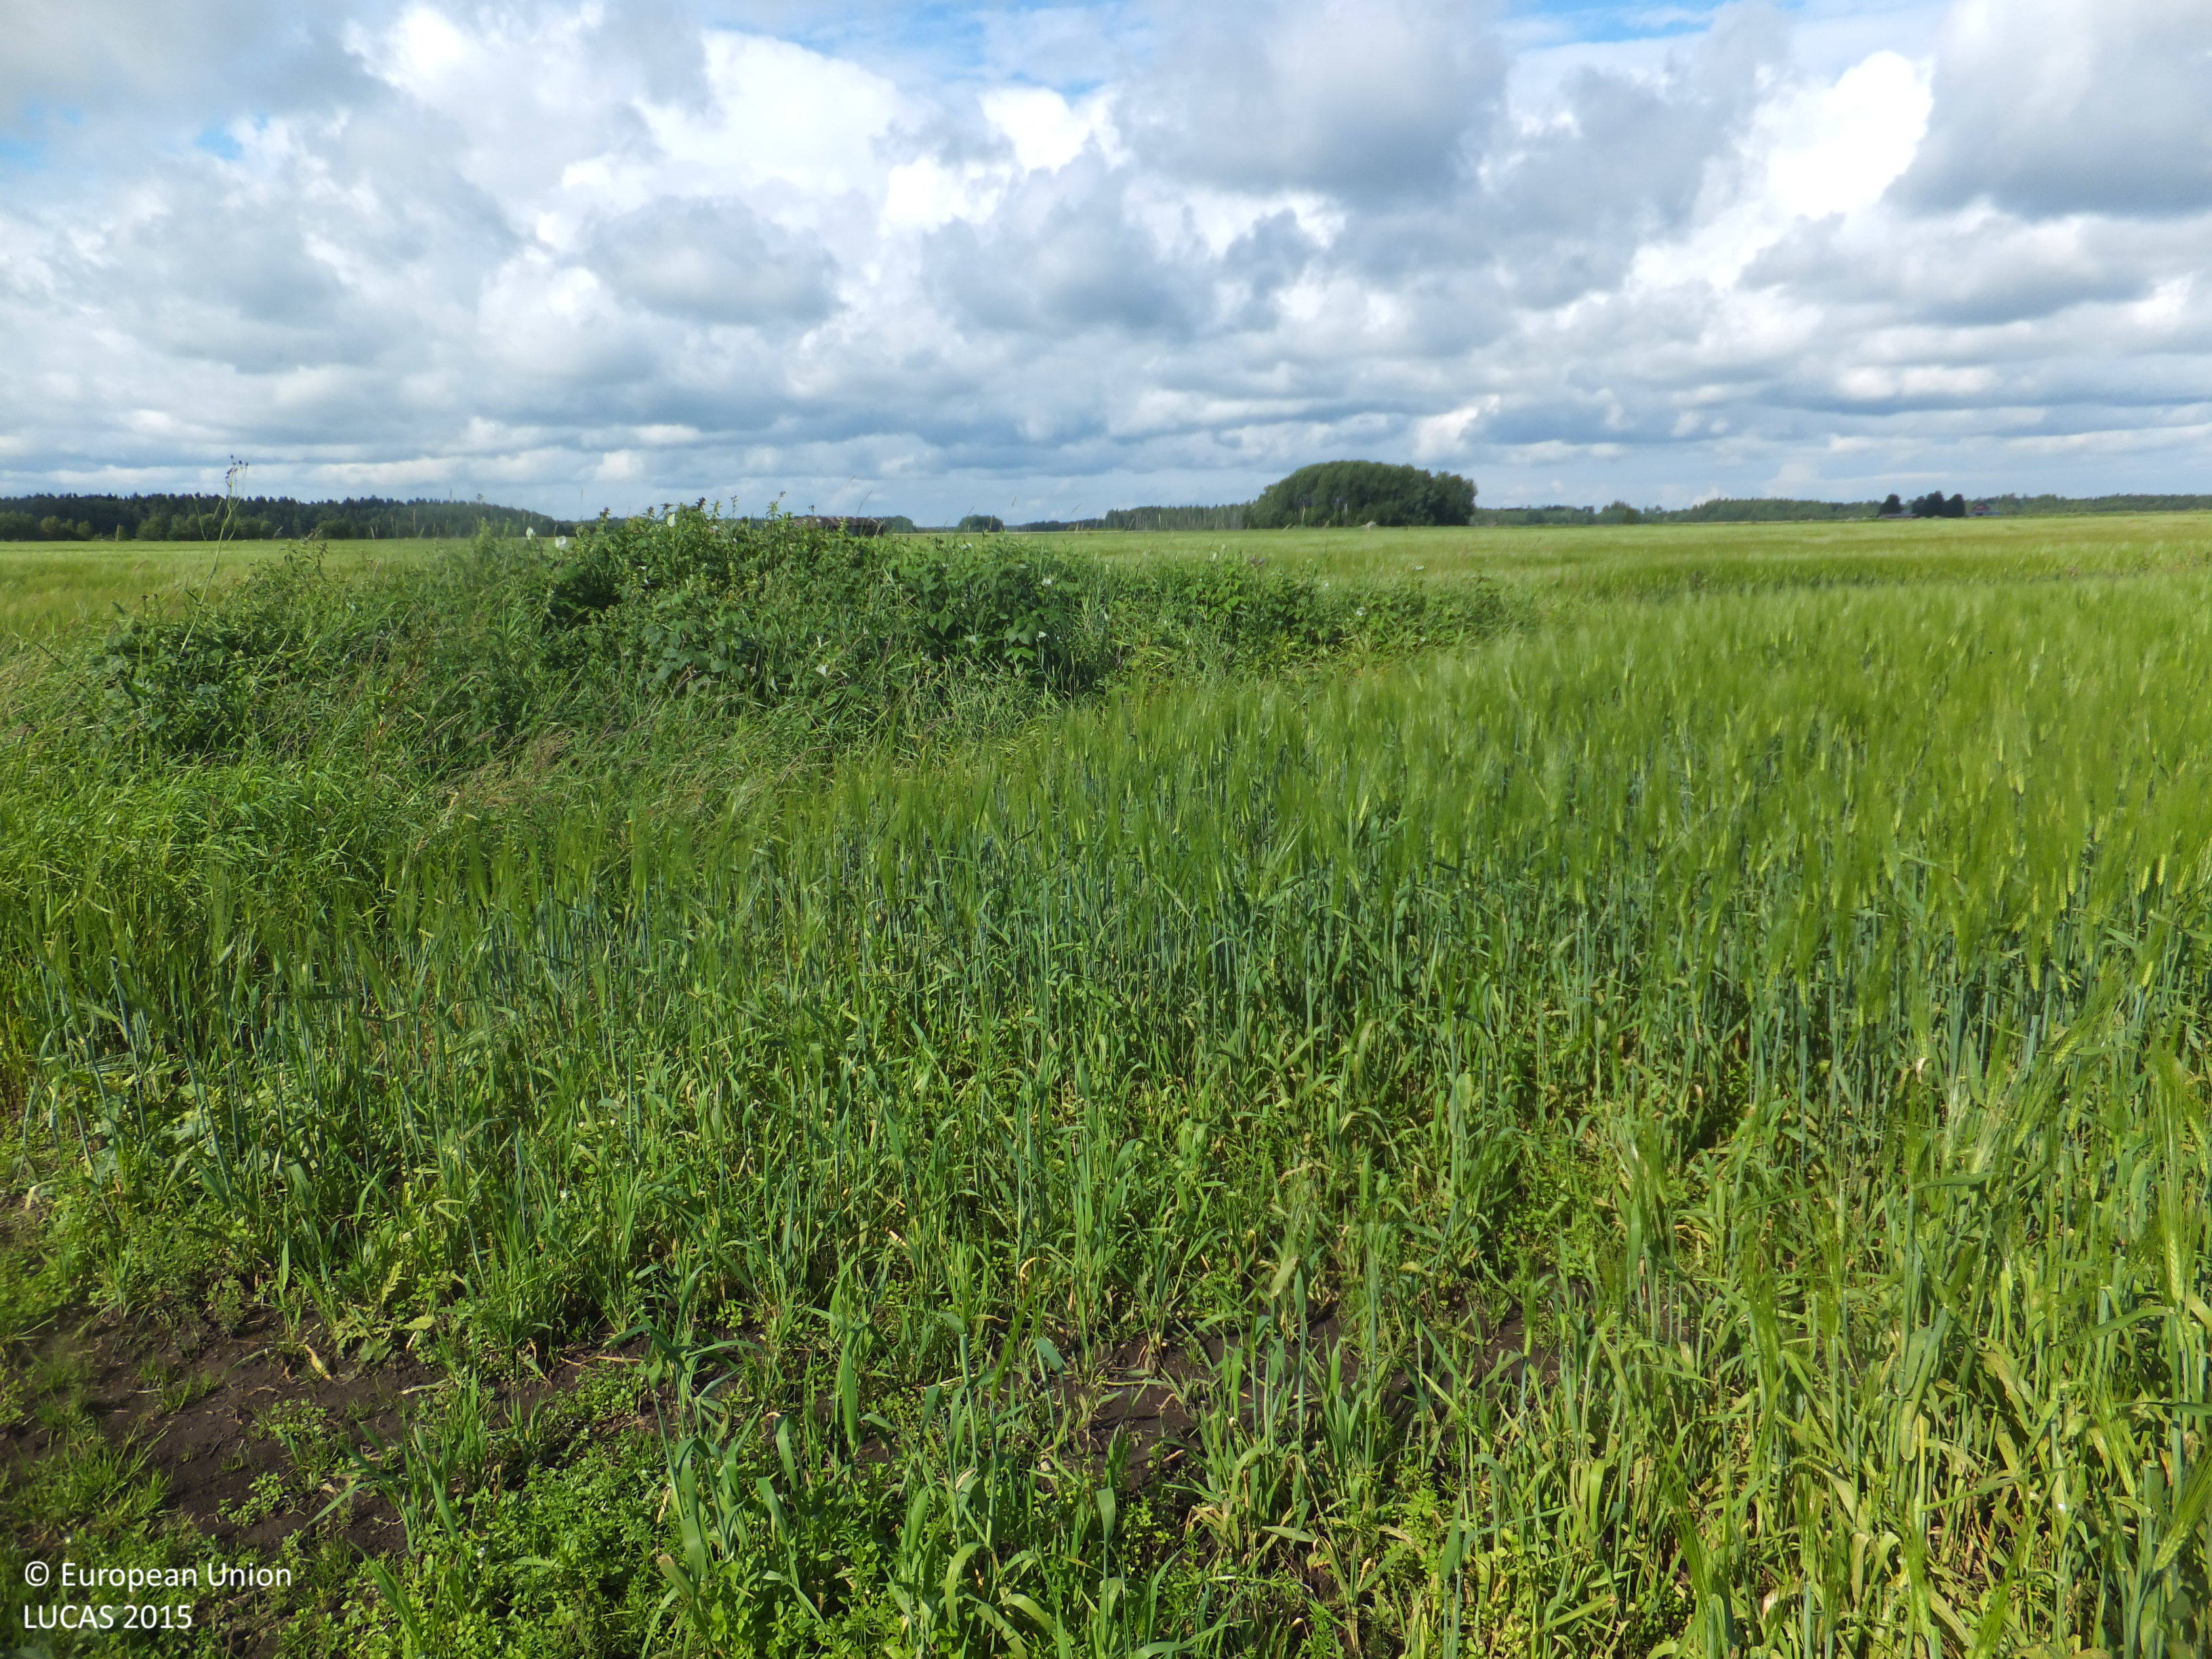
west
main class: Cropland
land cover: Barley
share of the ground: > 75 %
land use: Agriculture (excluding fallow land and kitchen gardens)
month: July
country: FI
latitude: 63.0639
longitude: 22.2163
